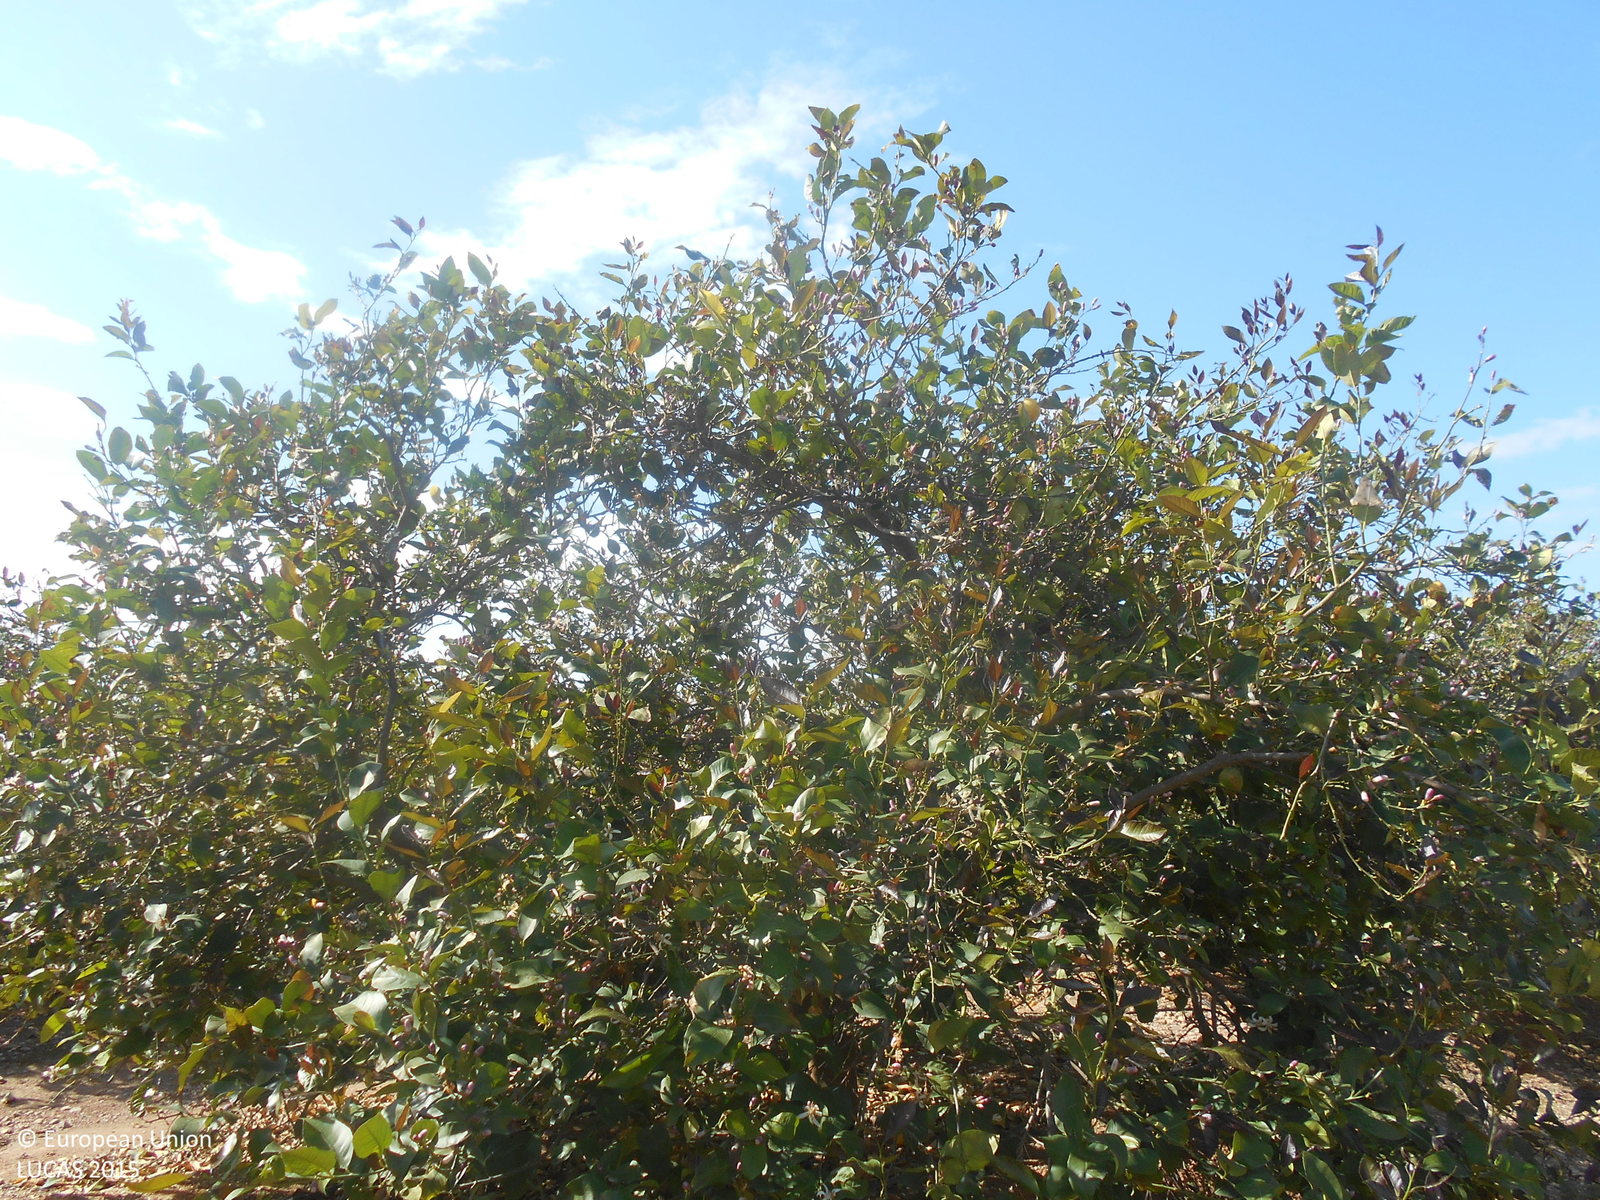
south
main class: Cropland
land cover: Other citrus fruit
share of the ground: 50 - 75 %
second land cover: Other bare soil
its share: > 75 %
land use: Agriculture (excluding fallow land and kitchen gardens)
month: April
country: ES
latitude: 37.7795
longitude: -1.3476
